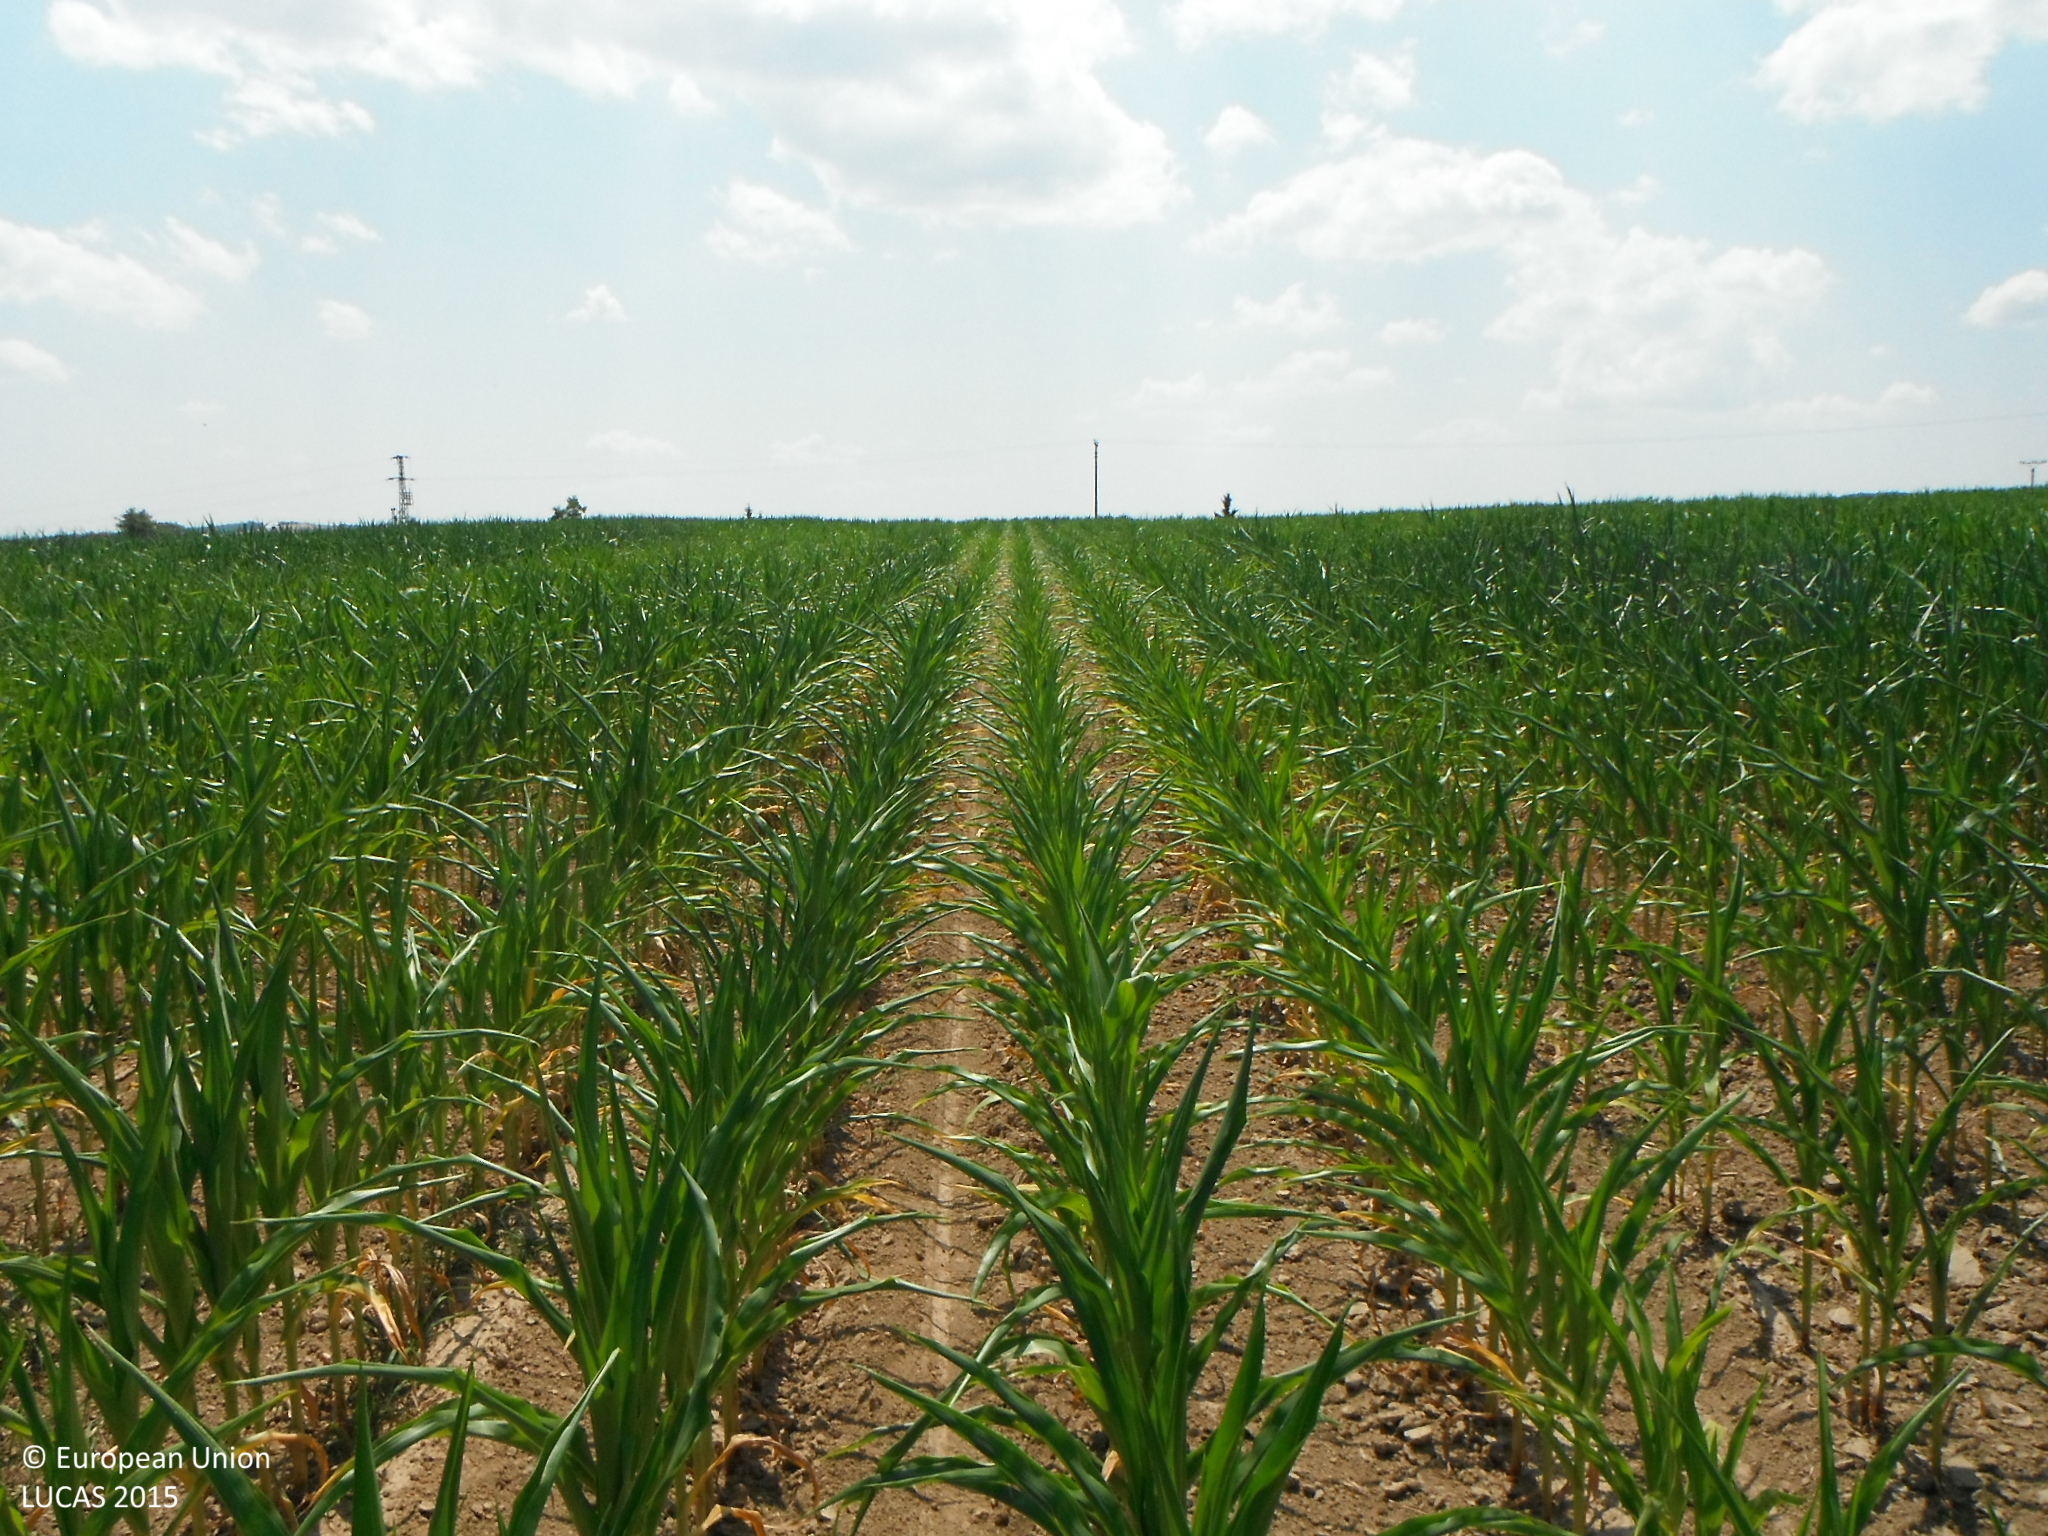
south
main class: Cropland
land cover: Maize
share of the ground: 50 - 75 %
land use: Agriculture (excluding fallow land and kitchen gardens)
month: July
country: SK
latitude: 48.4803
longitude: 19.0989
